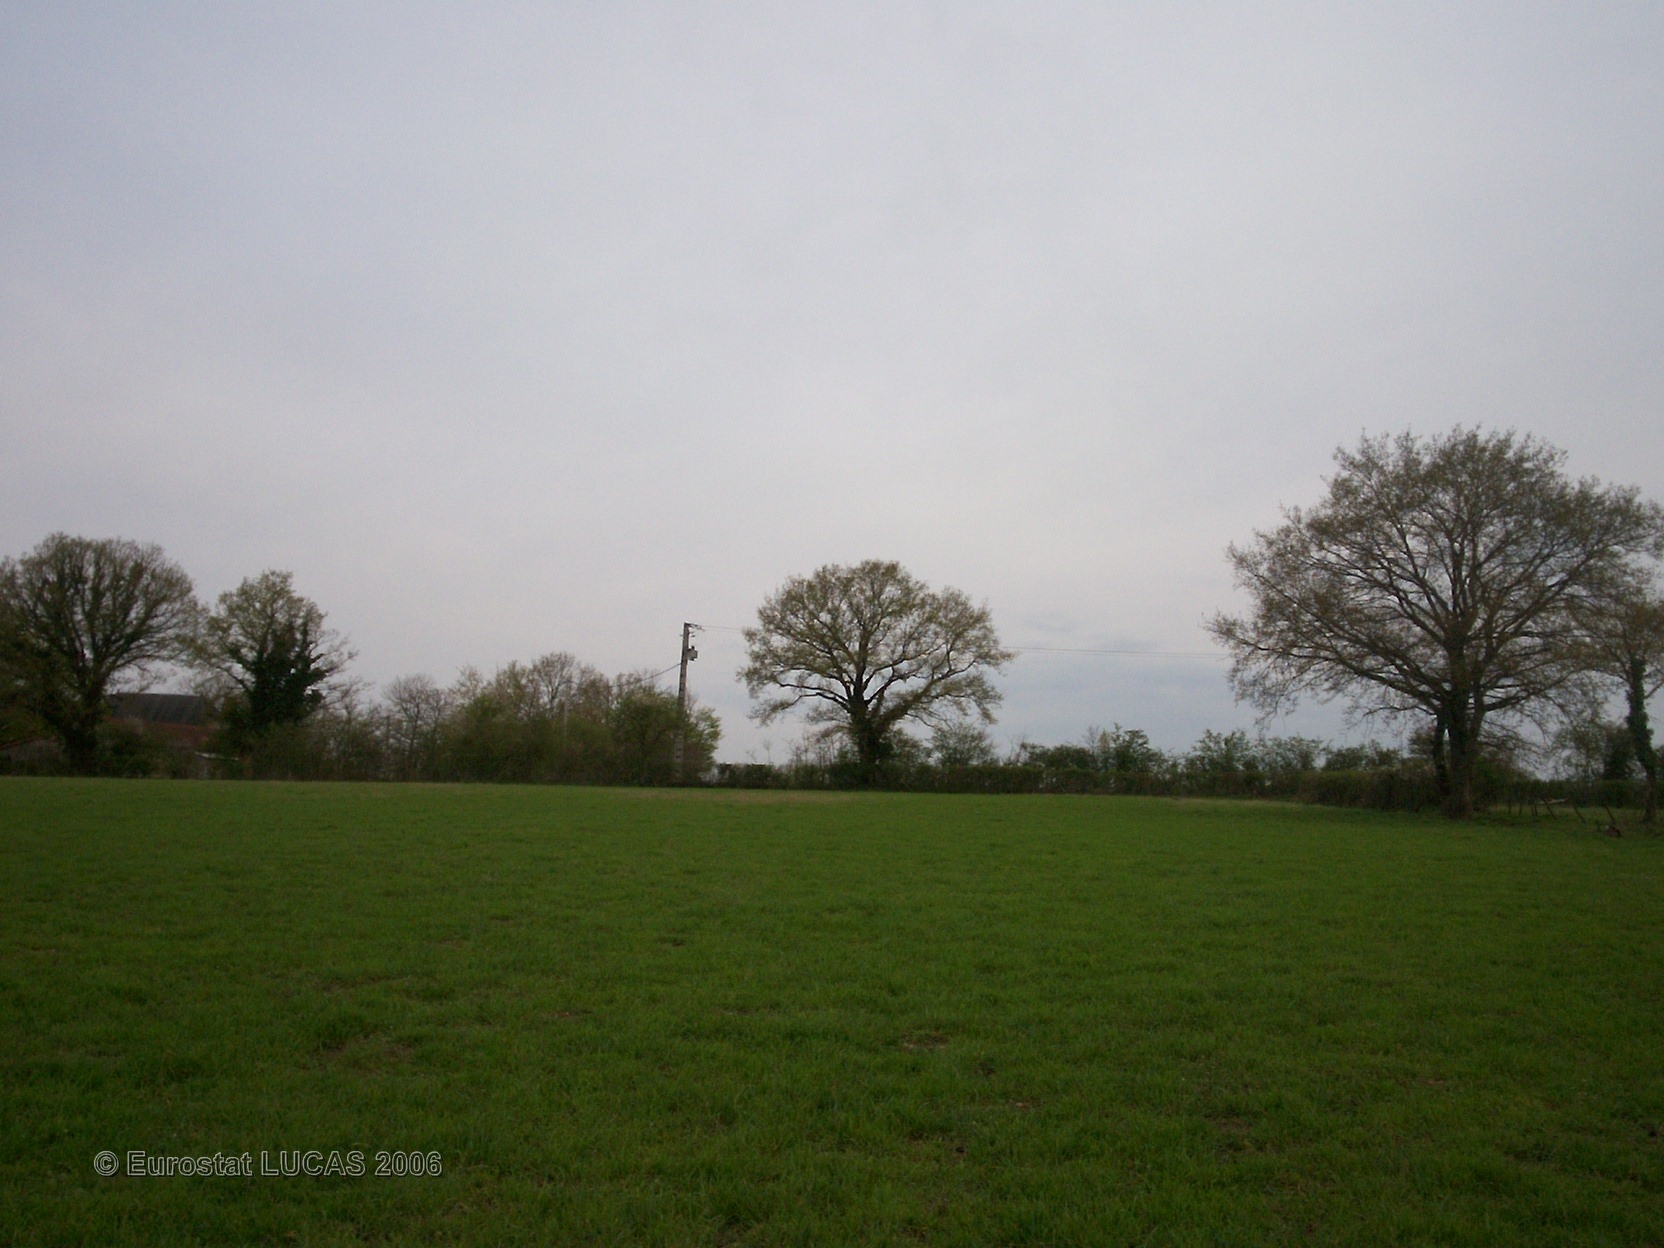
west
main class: Grassland
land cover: Grassland without tree/shrub cover
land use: Agriculture (excluding fallow land and kitchen gardens)
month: April
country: FR
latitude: 46.2137
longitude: 0.4561
